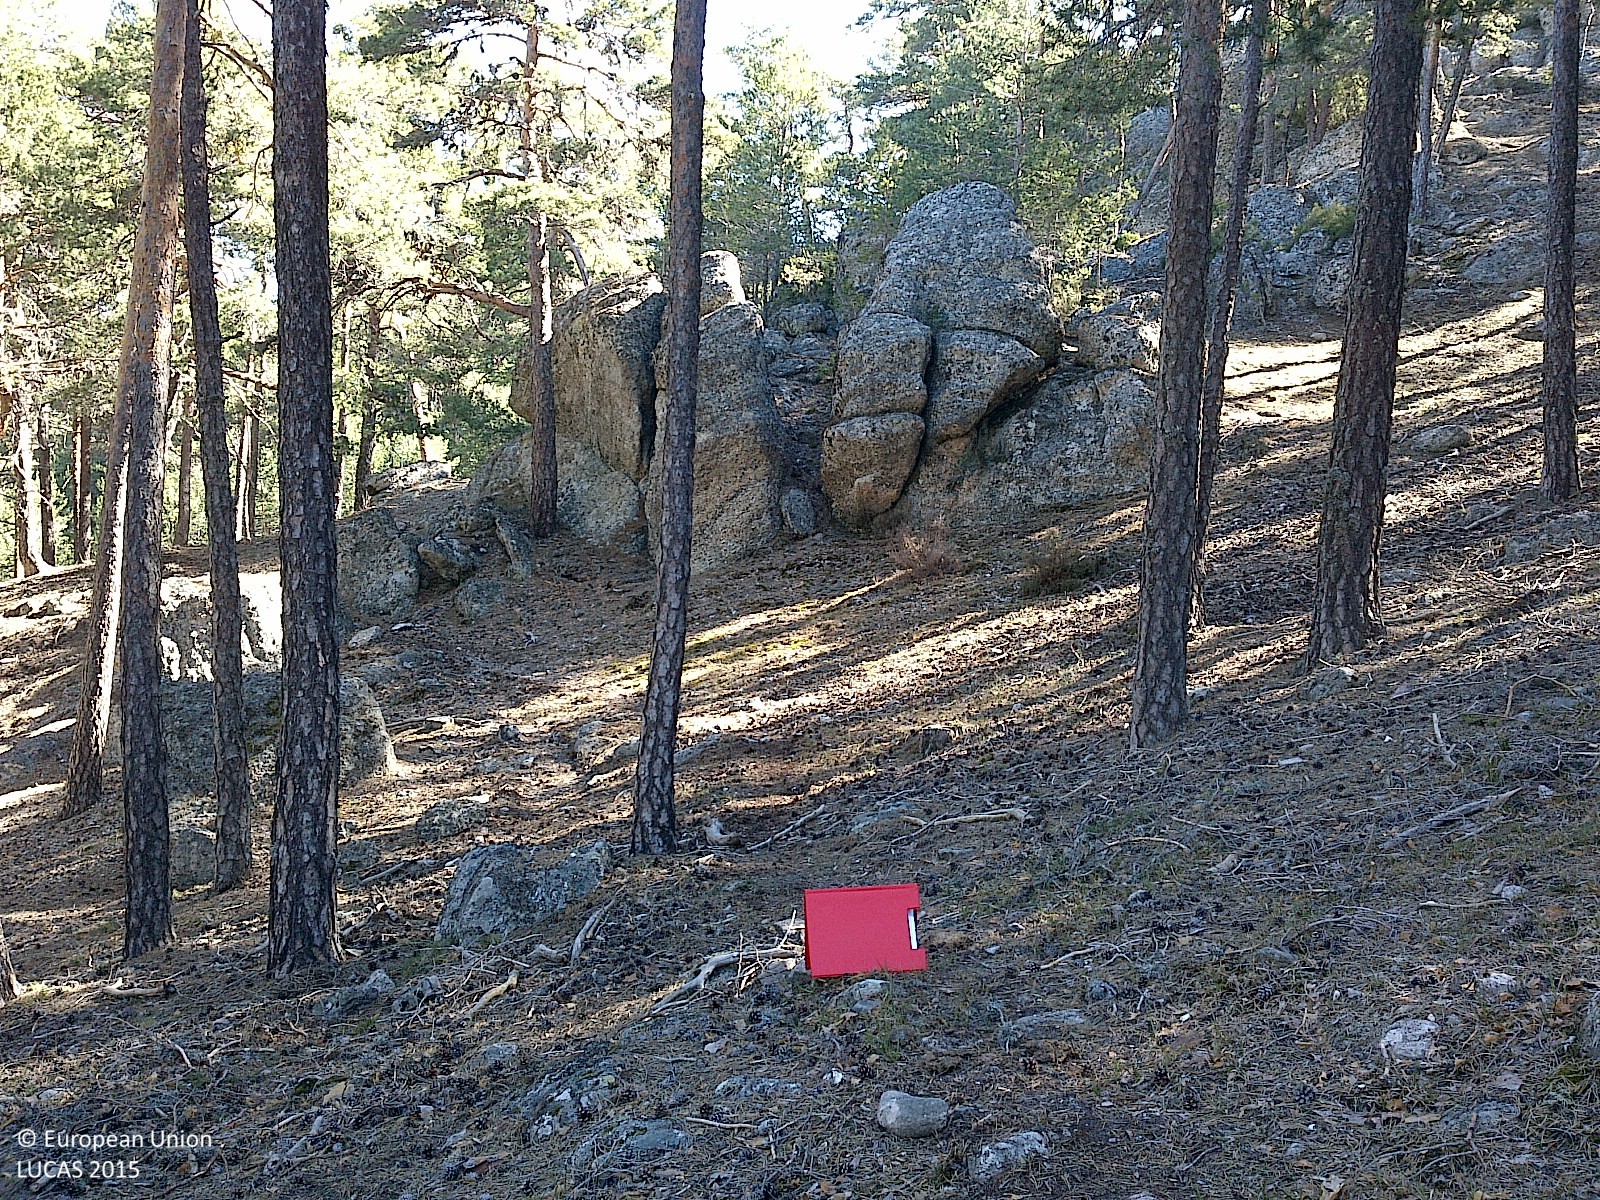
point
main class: Woodland
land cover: Pine dominated coniferous woodland
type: coniferous forest of the mediterranean region
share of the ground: > 75 %
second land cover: Grassland without tree/shrub cover
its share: 10 - 25 %
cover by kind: coniferous forest trees 75 %, herbaceous plants 15 %, unconsolidated bare surface 10 %
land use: Forestry
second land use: Agriculture (excluding fallow land and kitchen gardens)
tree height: > 5 m
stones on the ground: 10 - 25 %
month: April
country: ES
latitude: 41.9292
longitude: -3.0835
